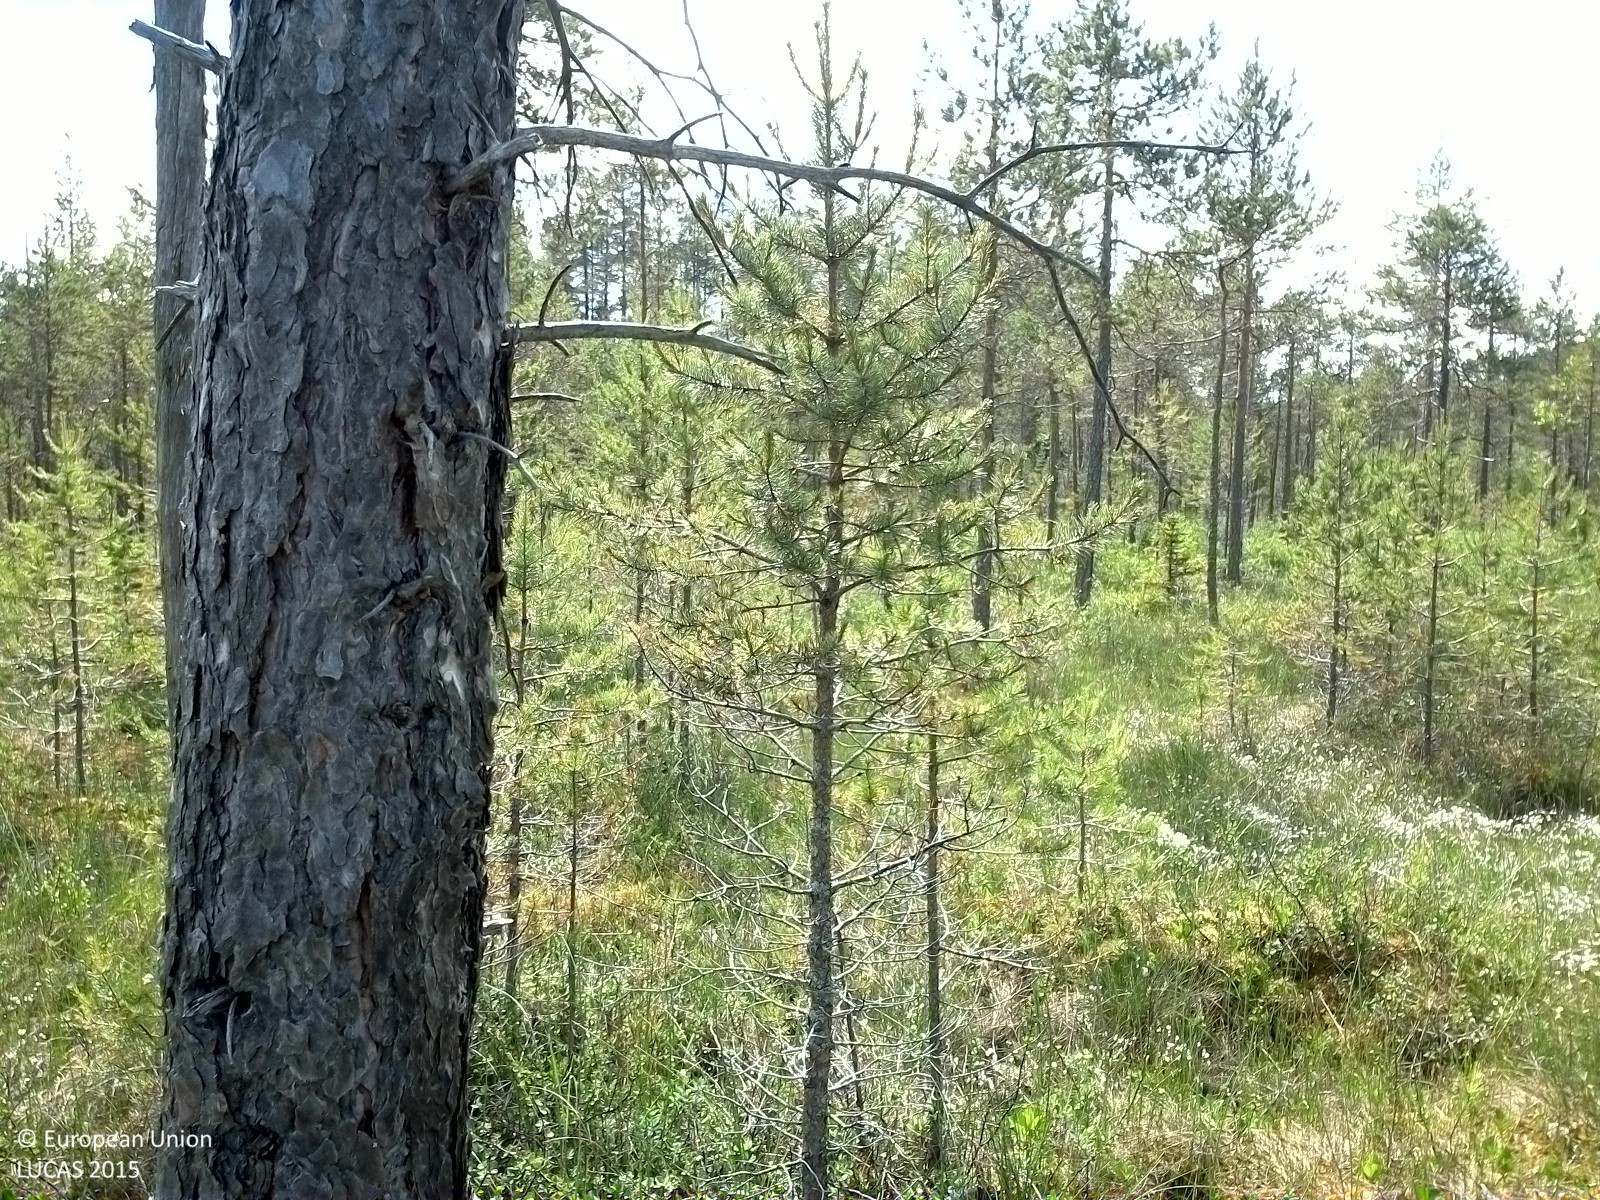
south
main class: Woodland
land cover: Pine dominated coniferous woodland
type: boreal forest
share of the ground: 10 - 25 %
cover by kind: shrubs 55 %, herbaceous plants 30 %, coniferous forest trees 10 %, lichens and mosses 5 %
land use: Semi-natural and natural areas not in use
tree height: < 5 m
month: July
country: SE
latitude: 62.6083
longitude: 17.0903
